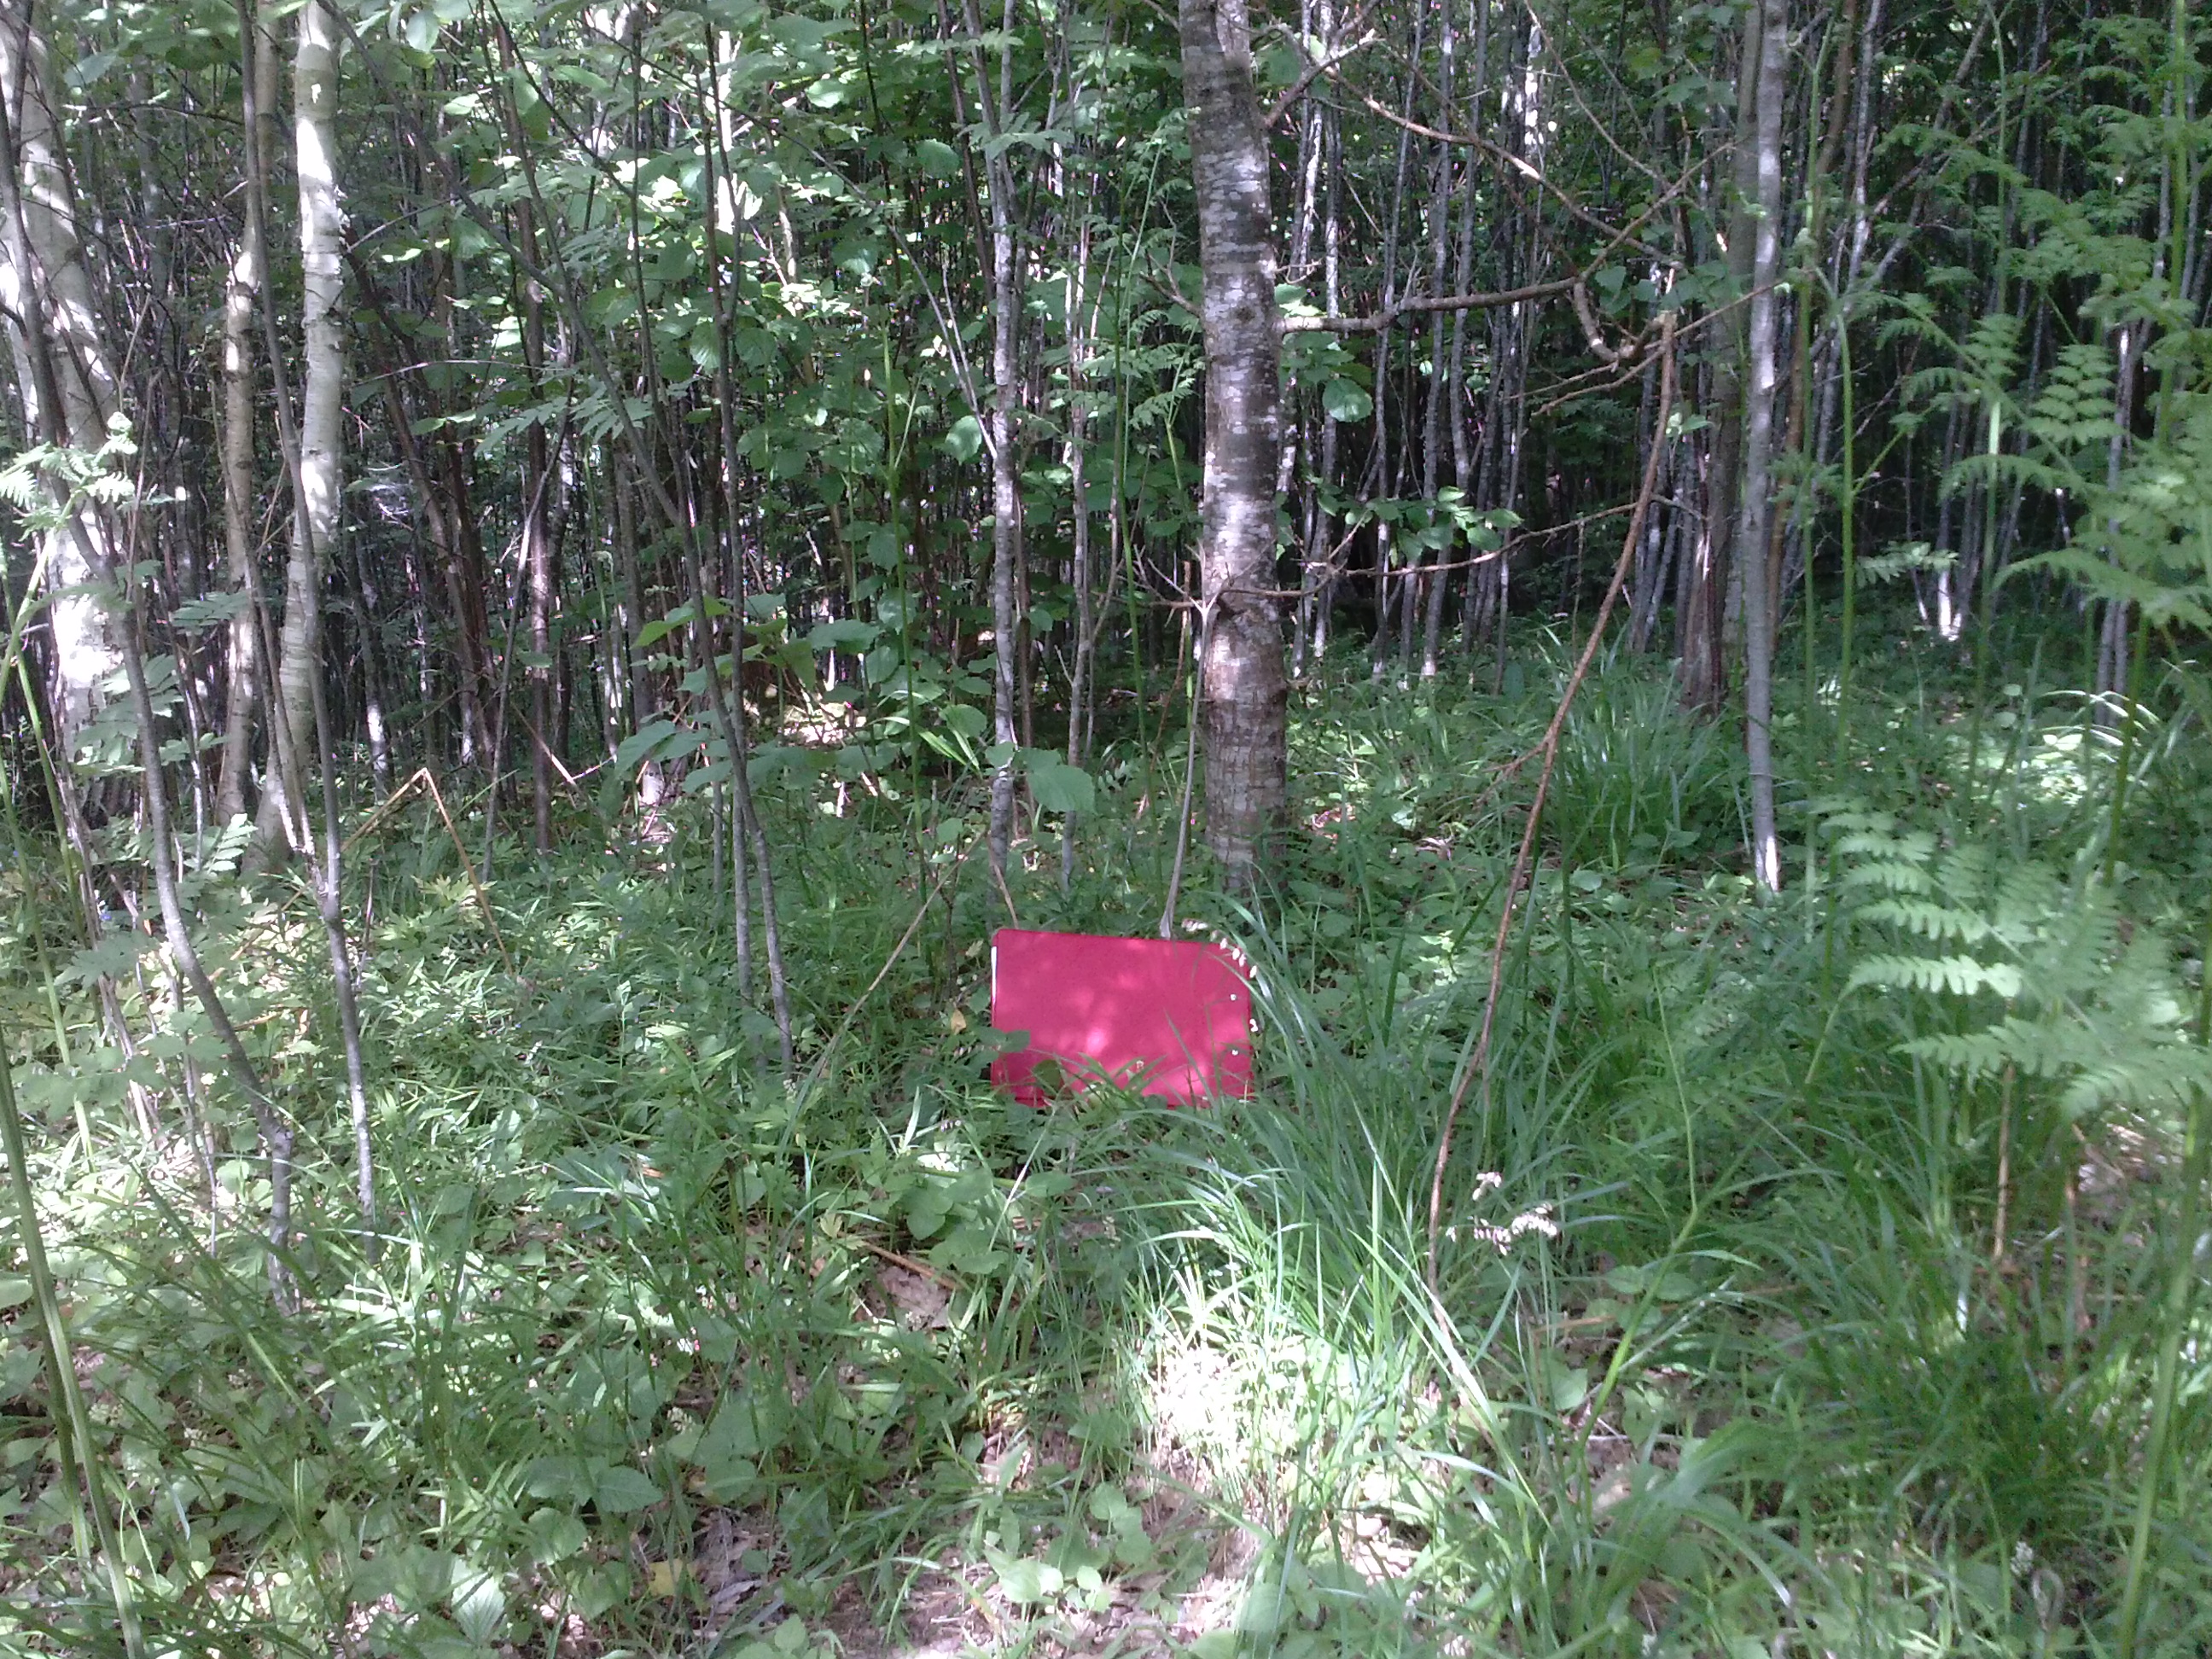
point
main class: Woodland
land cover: Broadleaved woodland
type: non-riverine alder, birch or aspen forest
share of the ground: > 75 %
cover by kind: broadleaved forest trees 100 %
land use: Forestry
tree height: > 5 m
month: June
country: LV
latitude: 56.4052
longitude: 27.4023
